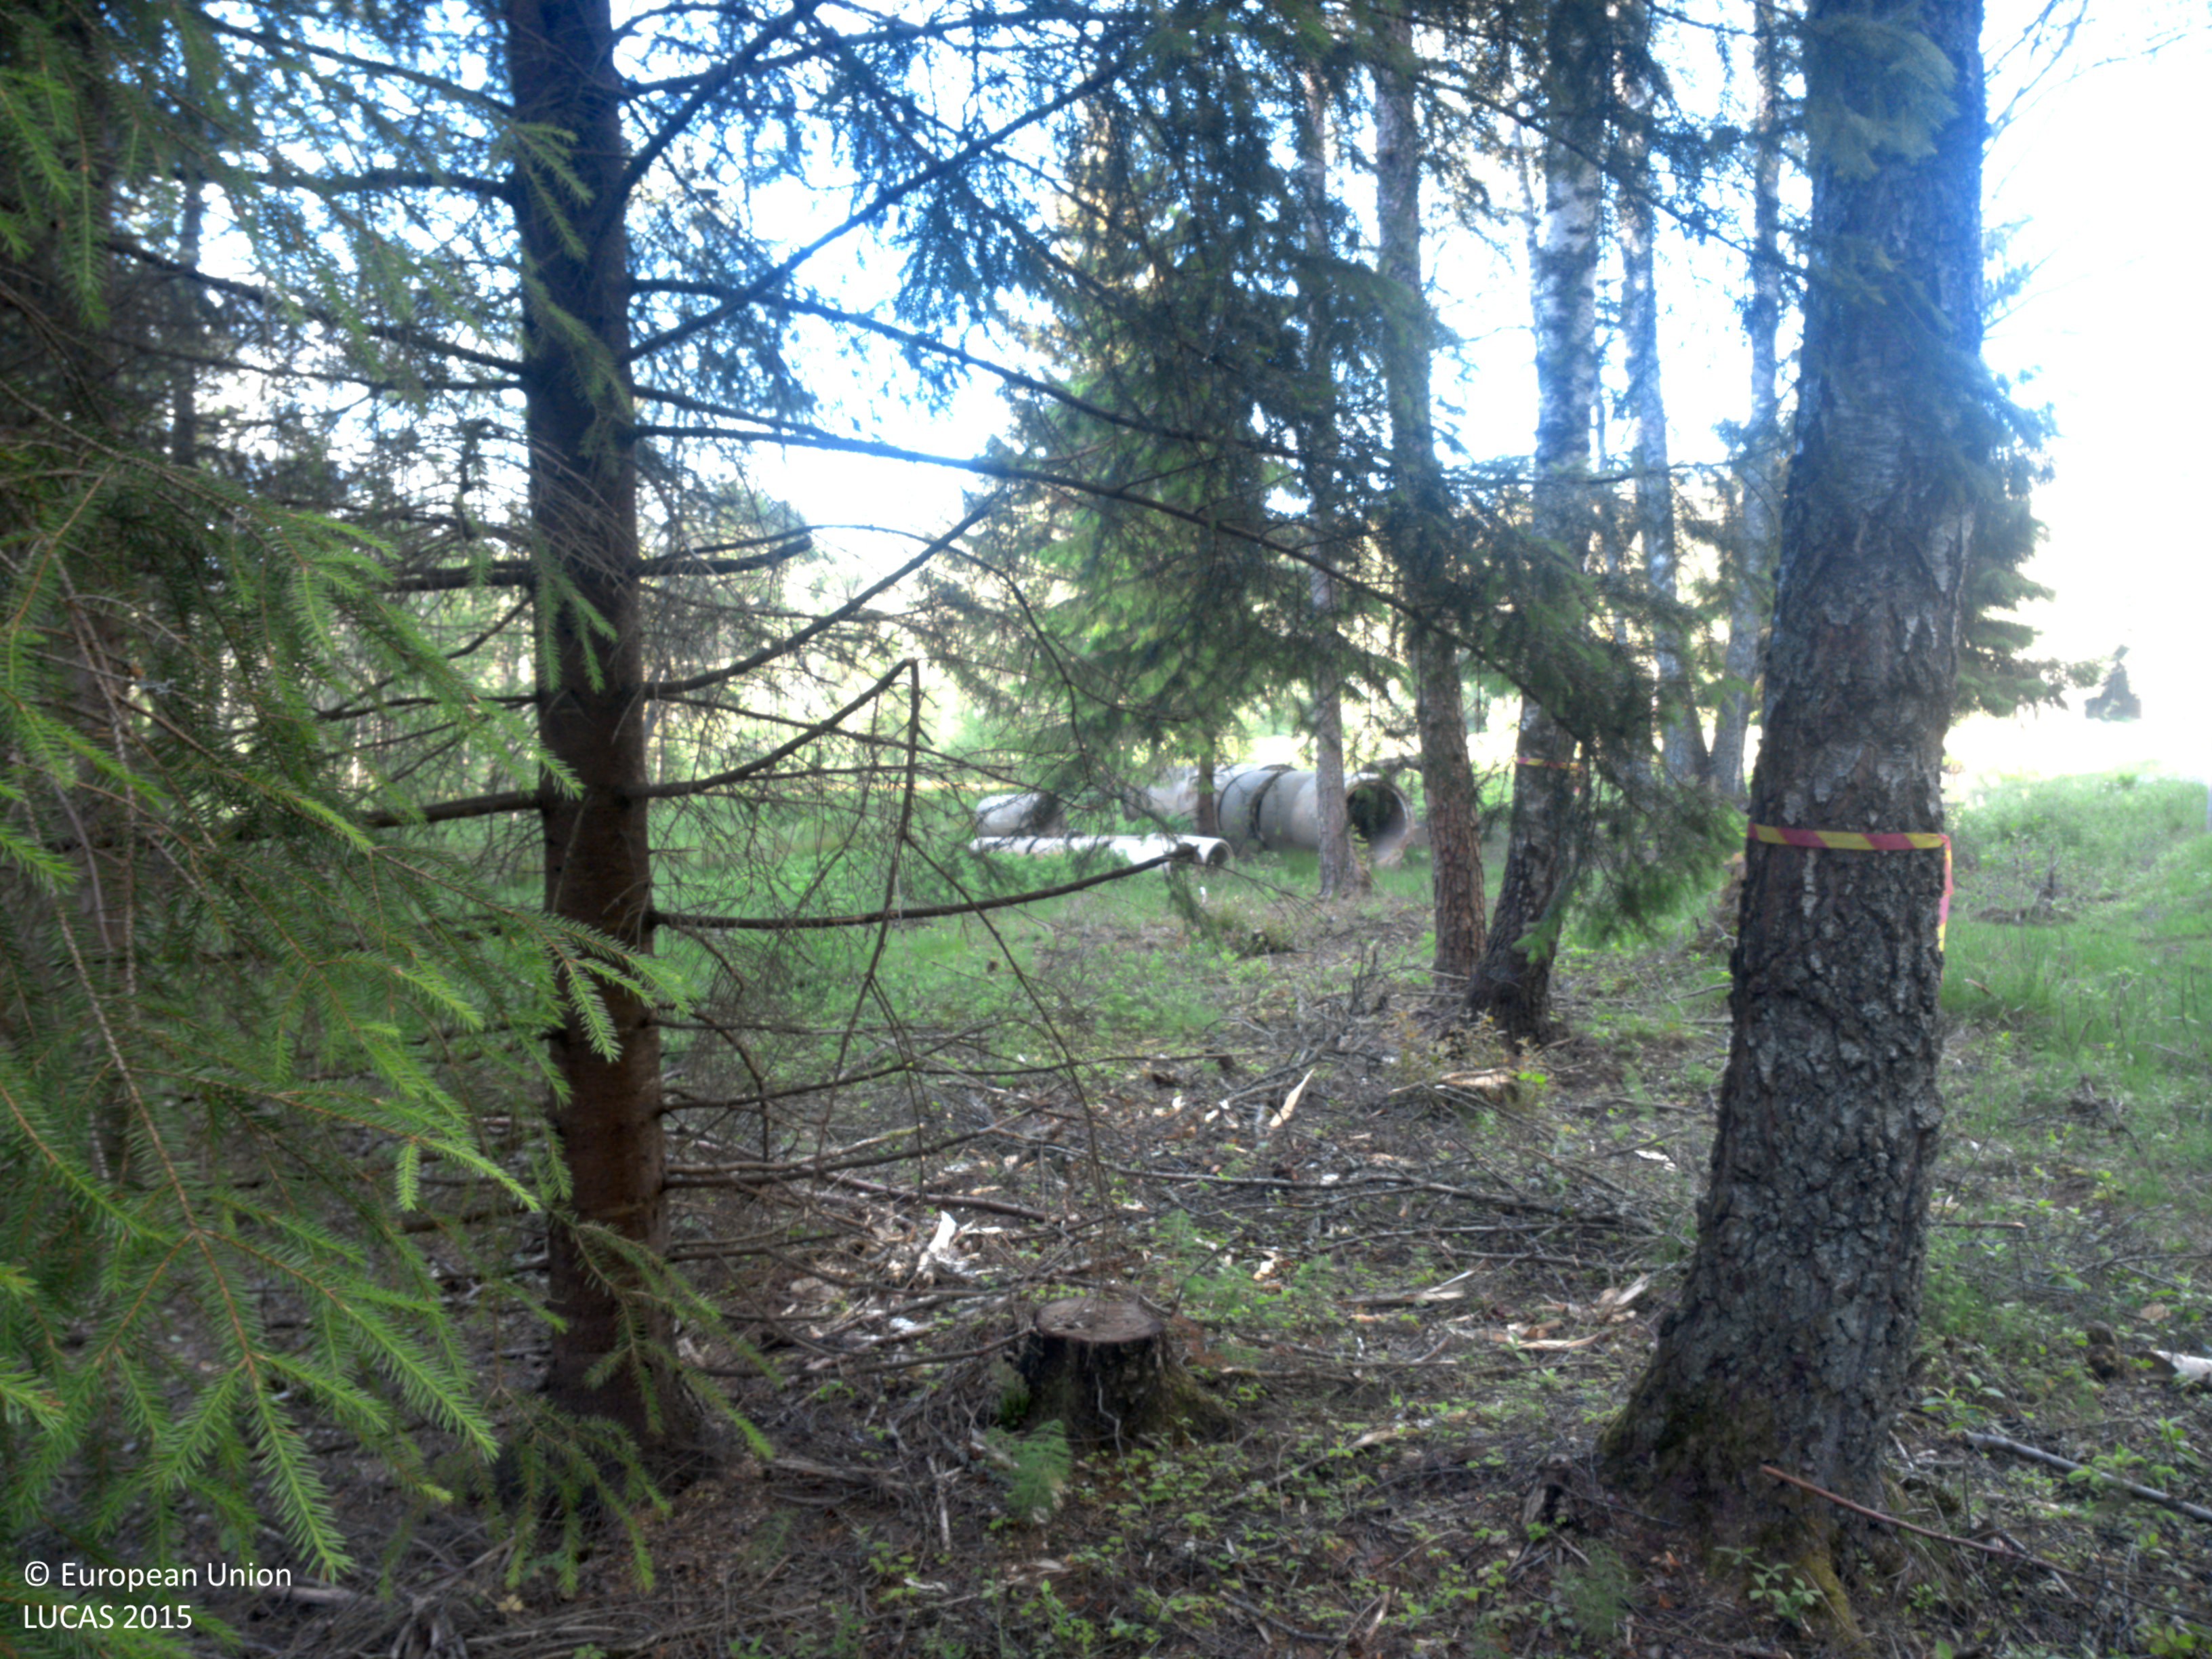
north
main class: Woodland
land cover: Spruce dominated mixed woodland
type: boreal forest
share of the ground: 50 - 75 %
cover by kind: coniferous forest trees 40 %, herbaceous plants 30 %, broadleaved forest trees 25 %, shrubs 5 %
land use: Forestry
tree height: > 5 m
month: June
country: SE
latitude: 58.8583
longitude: 11.5393
